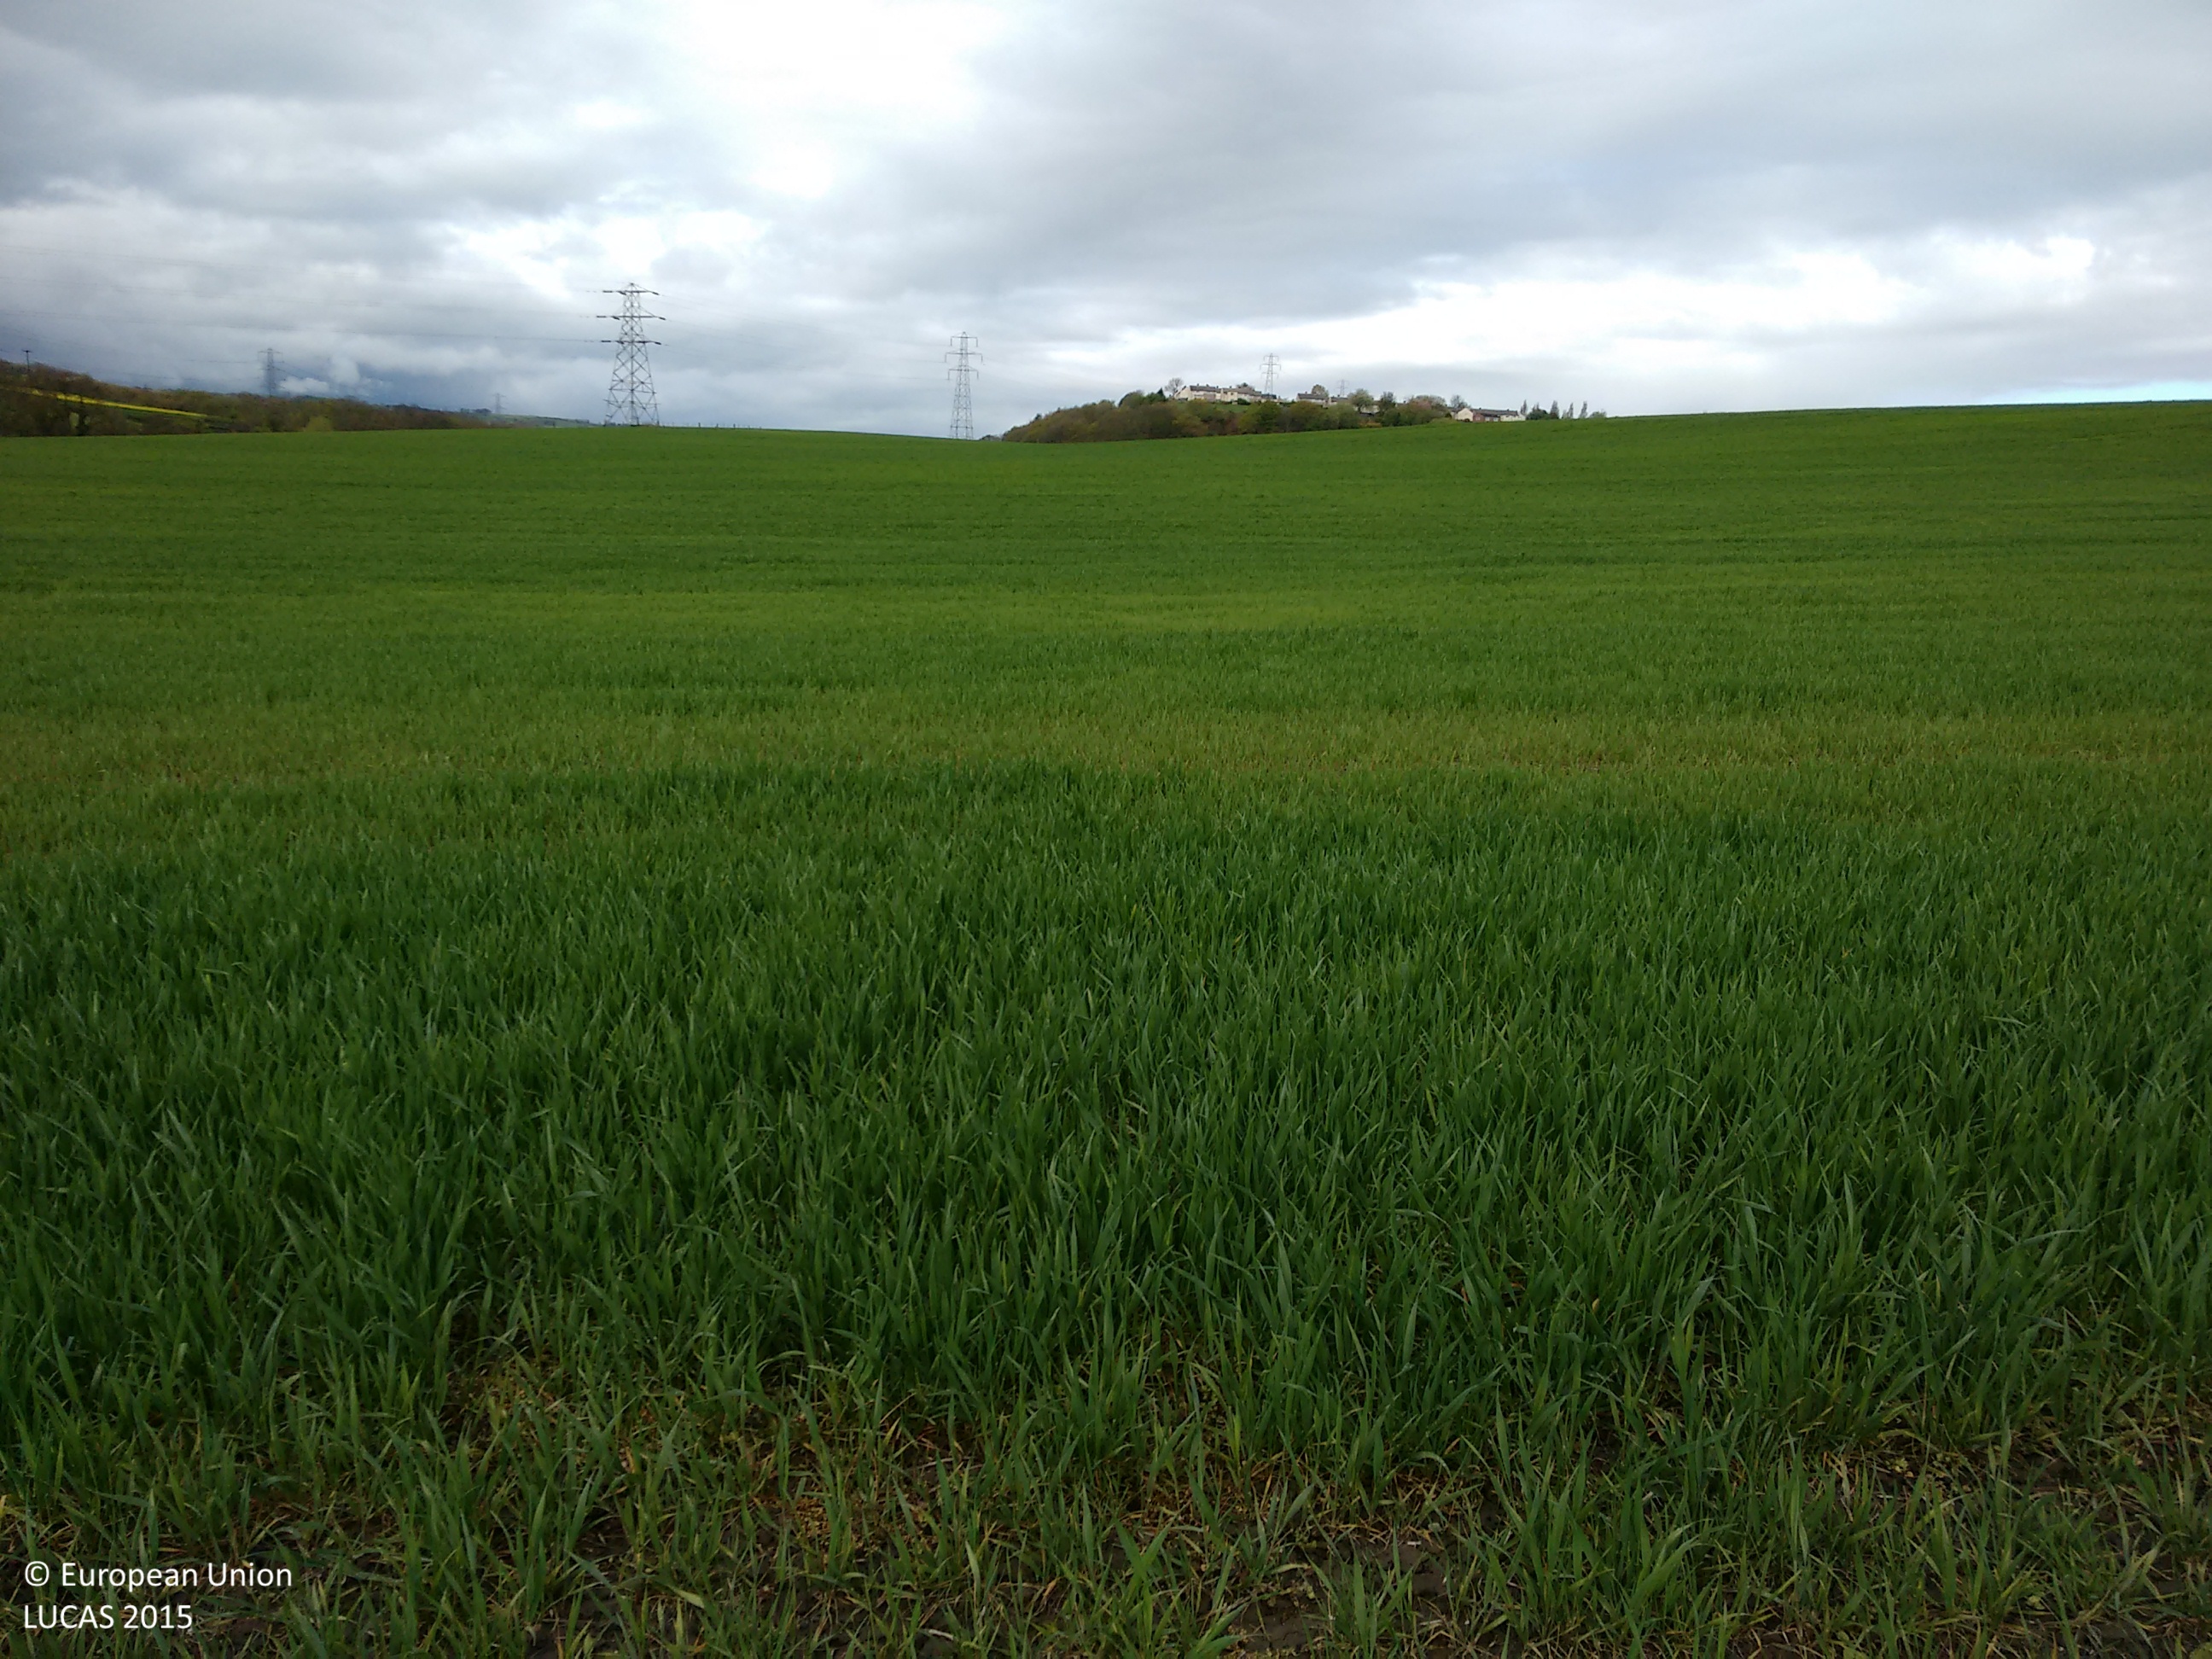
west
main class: Cropland
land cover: Common wheat
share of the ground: > 75 %
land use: Agriculture (excluding fallow land and kitchen gardens)
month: April
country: GB
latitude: 53.6603
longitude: -1.5974
